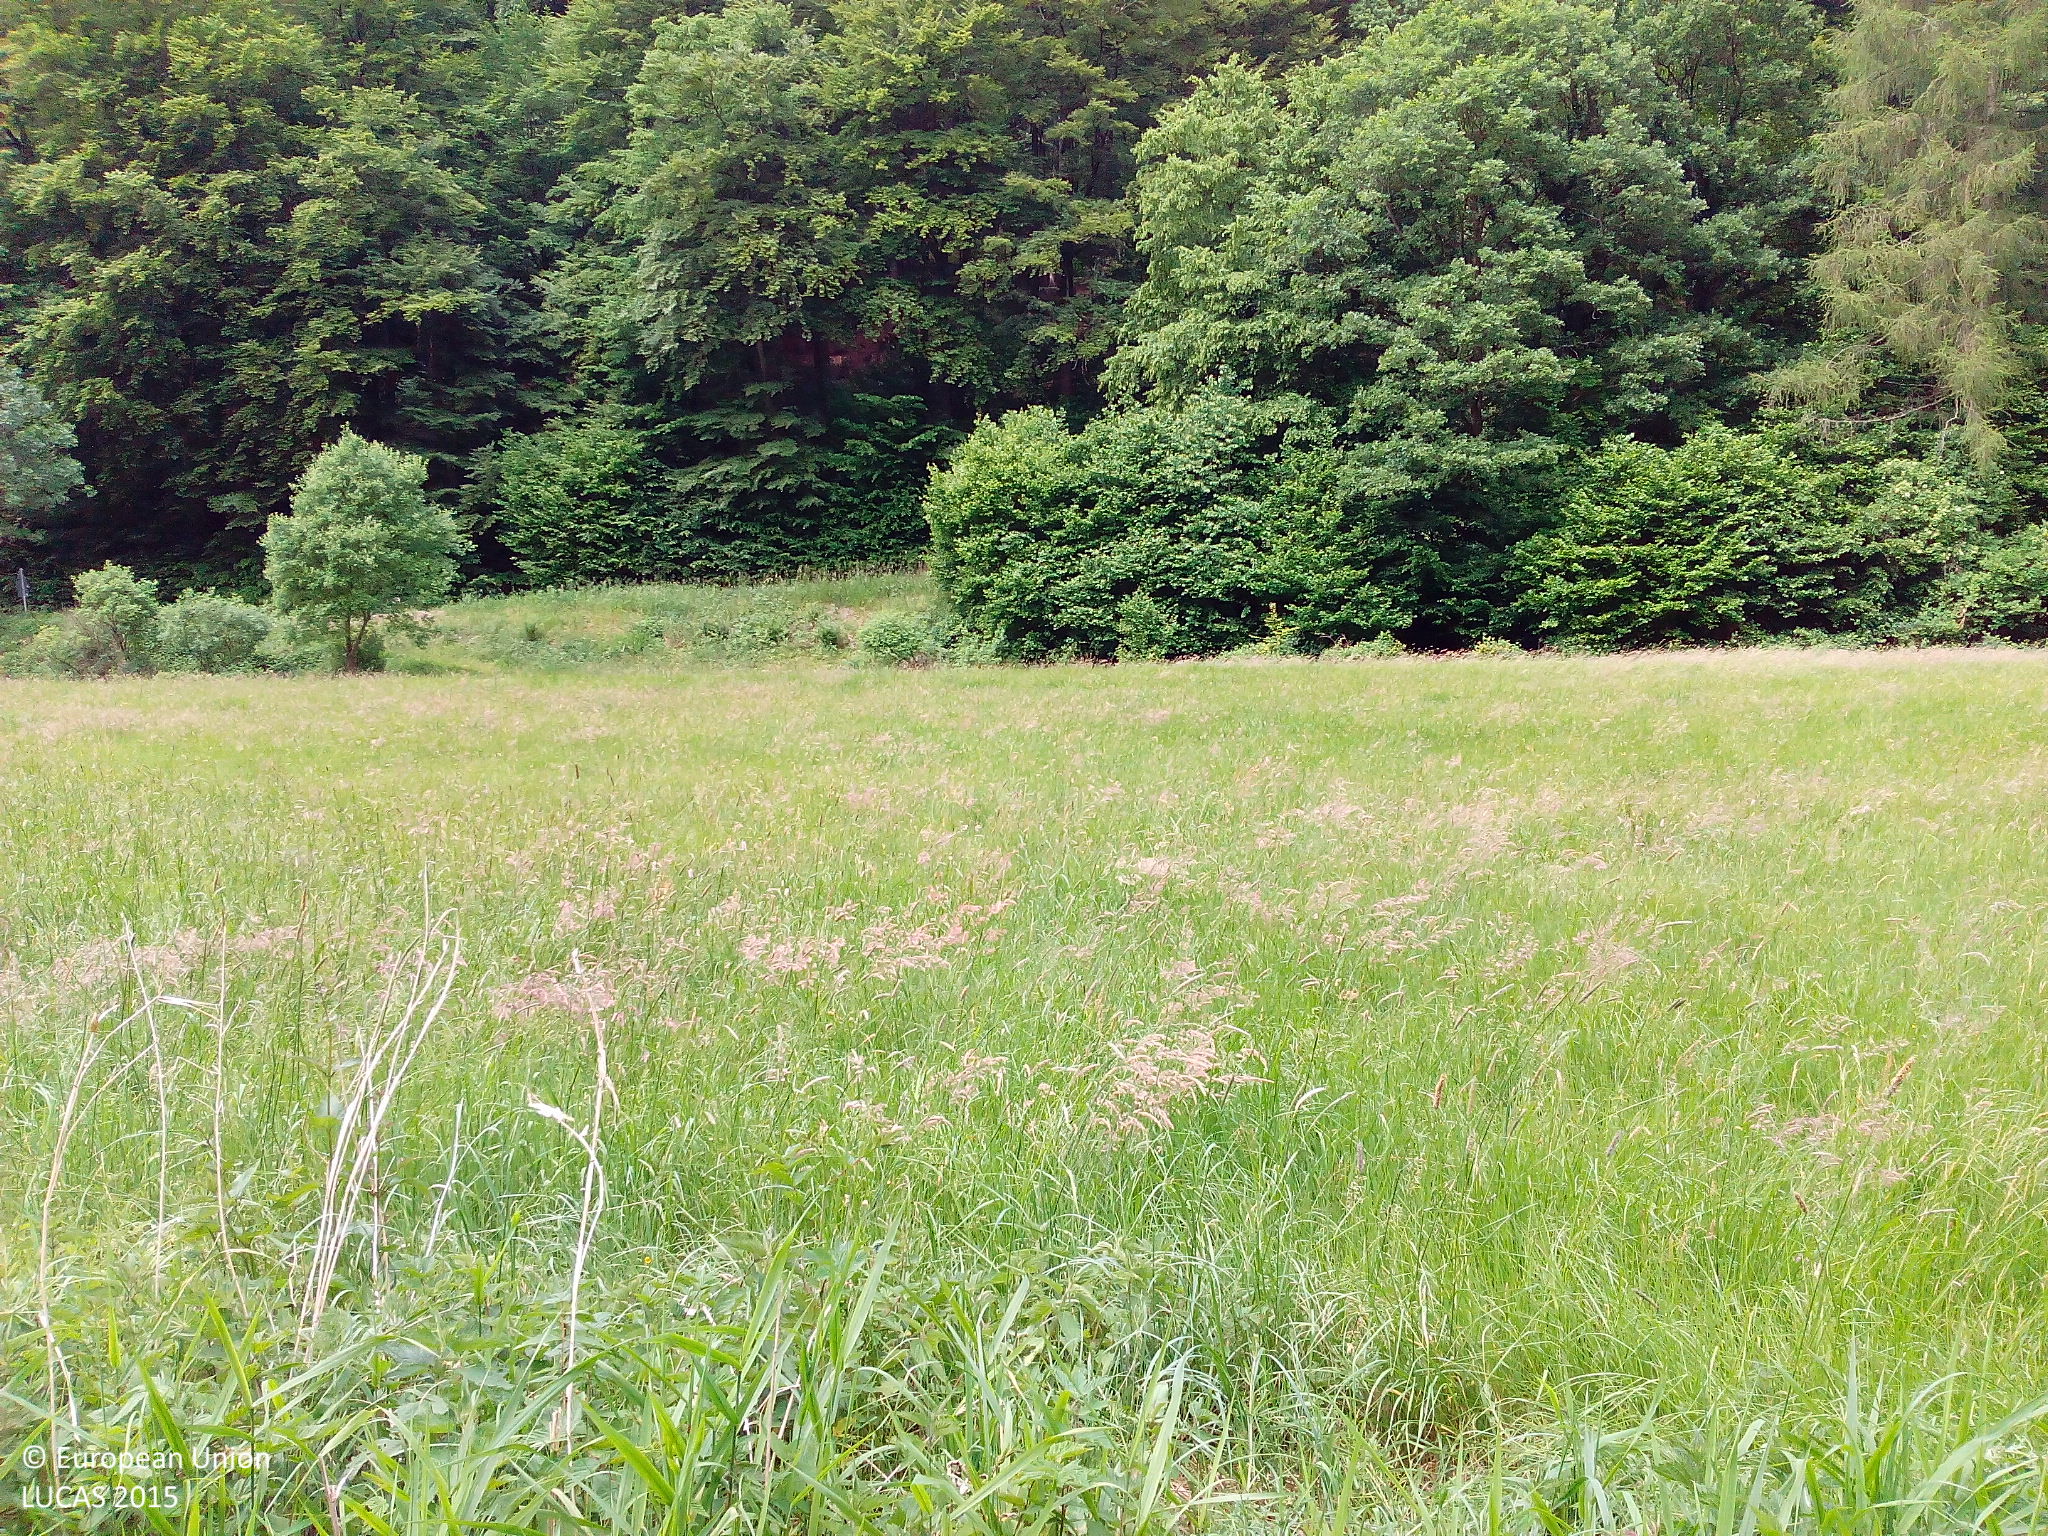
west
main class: Woodland
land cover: Broadleaved woodland
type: beech forest
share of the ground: > 75 %
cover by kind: broadleaved forest trees 100 %
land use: Forestry
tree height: > 5 m
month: June
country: DE
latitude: 51.1545
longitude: 9.6141
